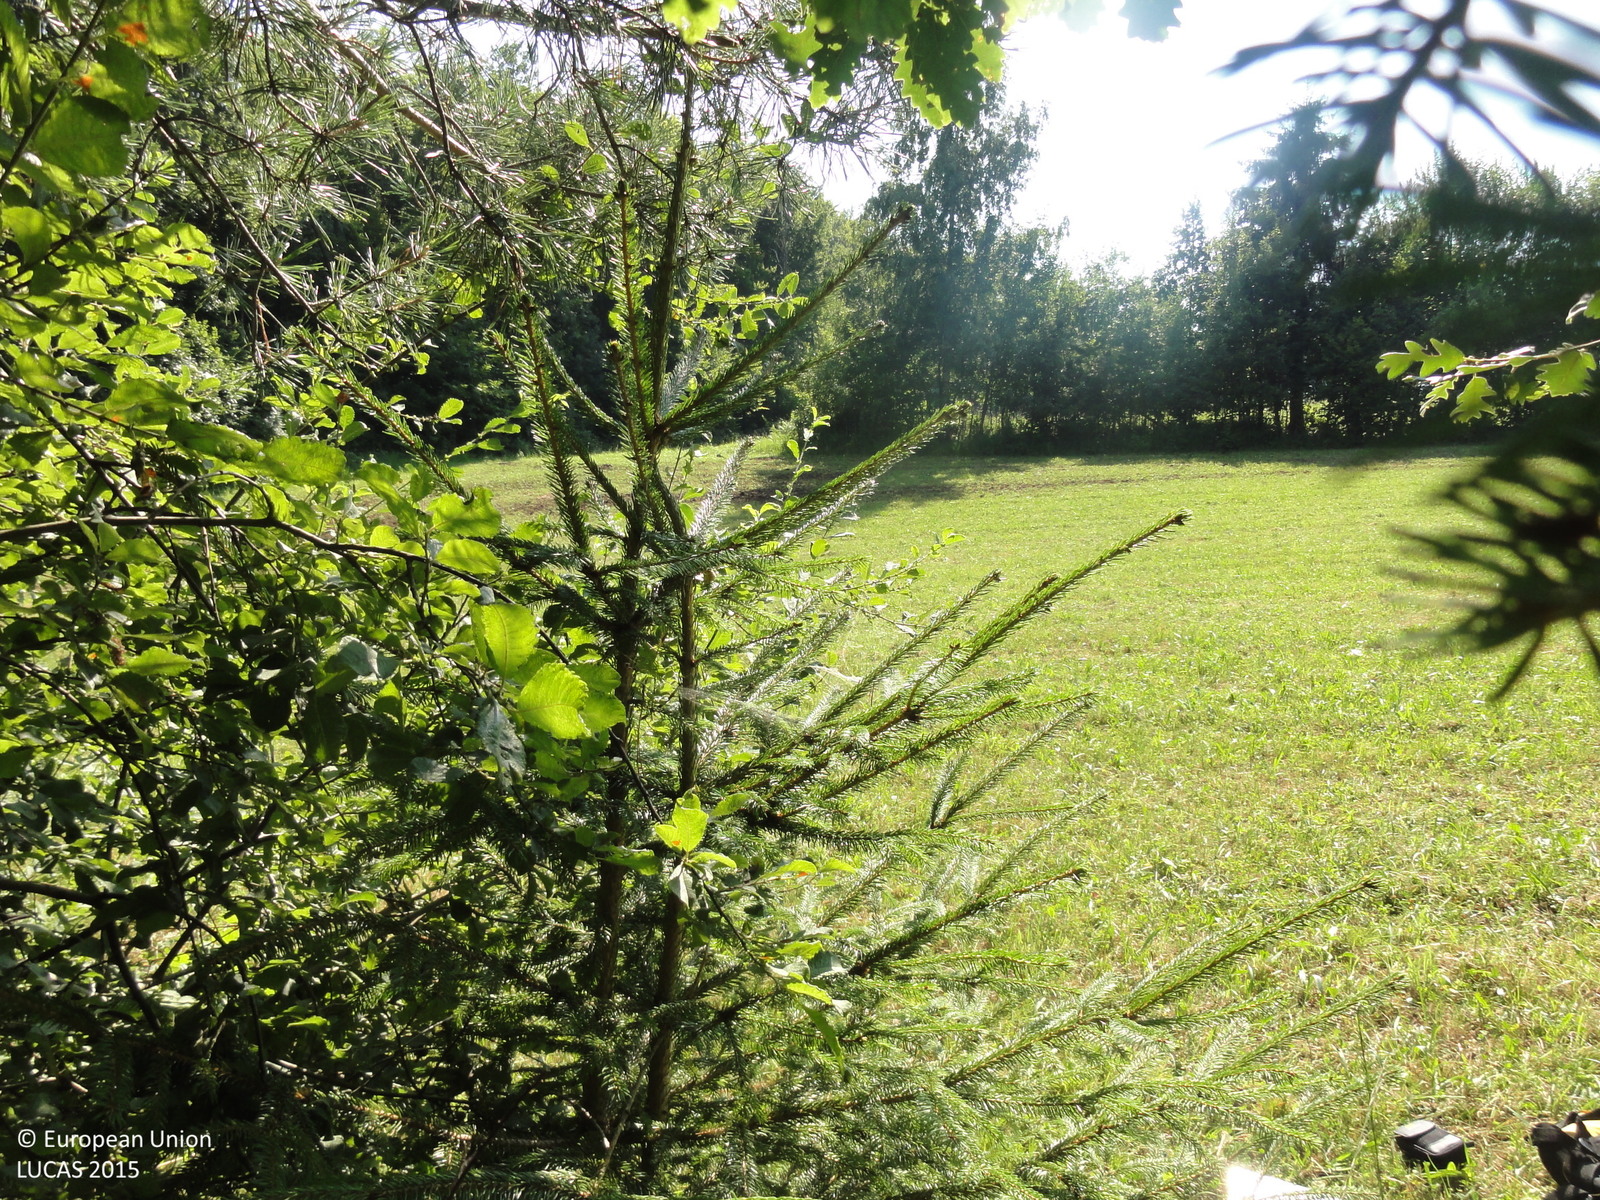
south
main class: Woodland
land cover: Spruce dominated mixed woodland
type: mesophytic deciduous forest
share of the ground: > 75 %
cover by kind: broadleaved forest trees 50 %, coniferous forest trees 40 %, shrubs 10 %
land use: Forestry
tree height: > 5 m
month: August
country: SI
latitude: 46.0155
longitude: 15.0471
